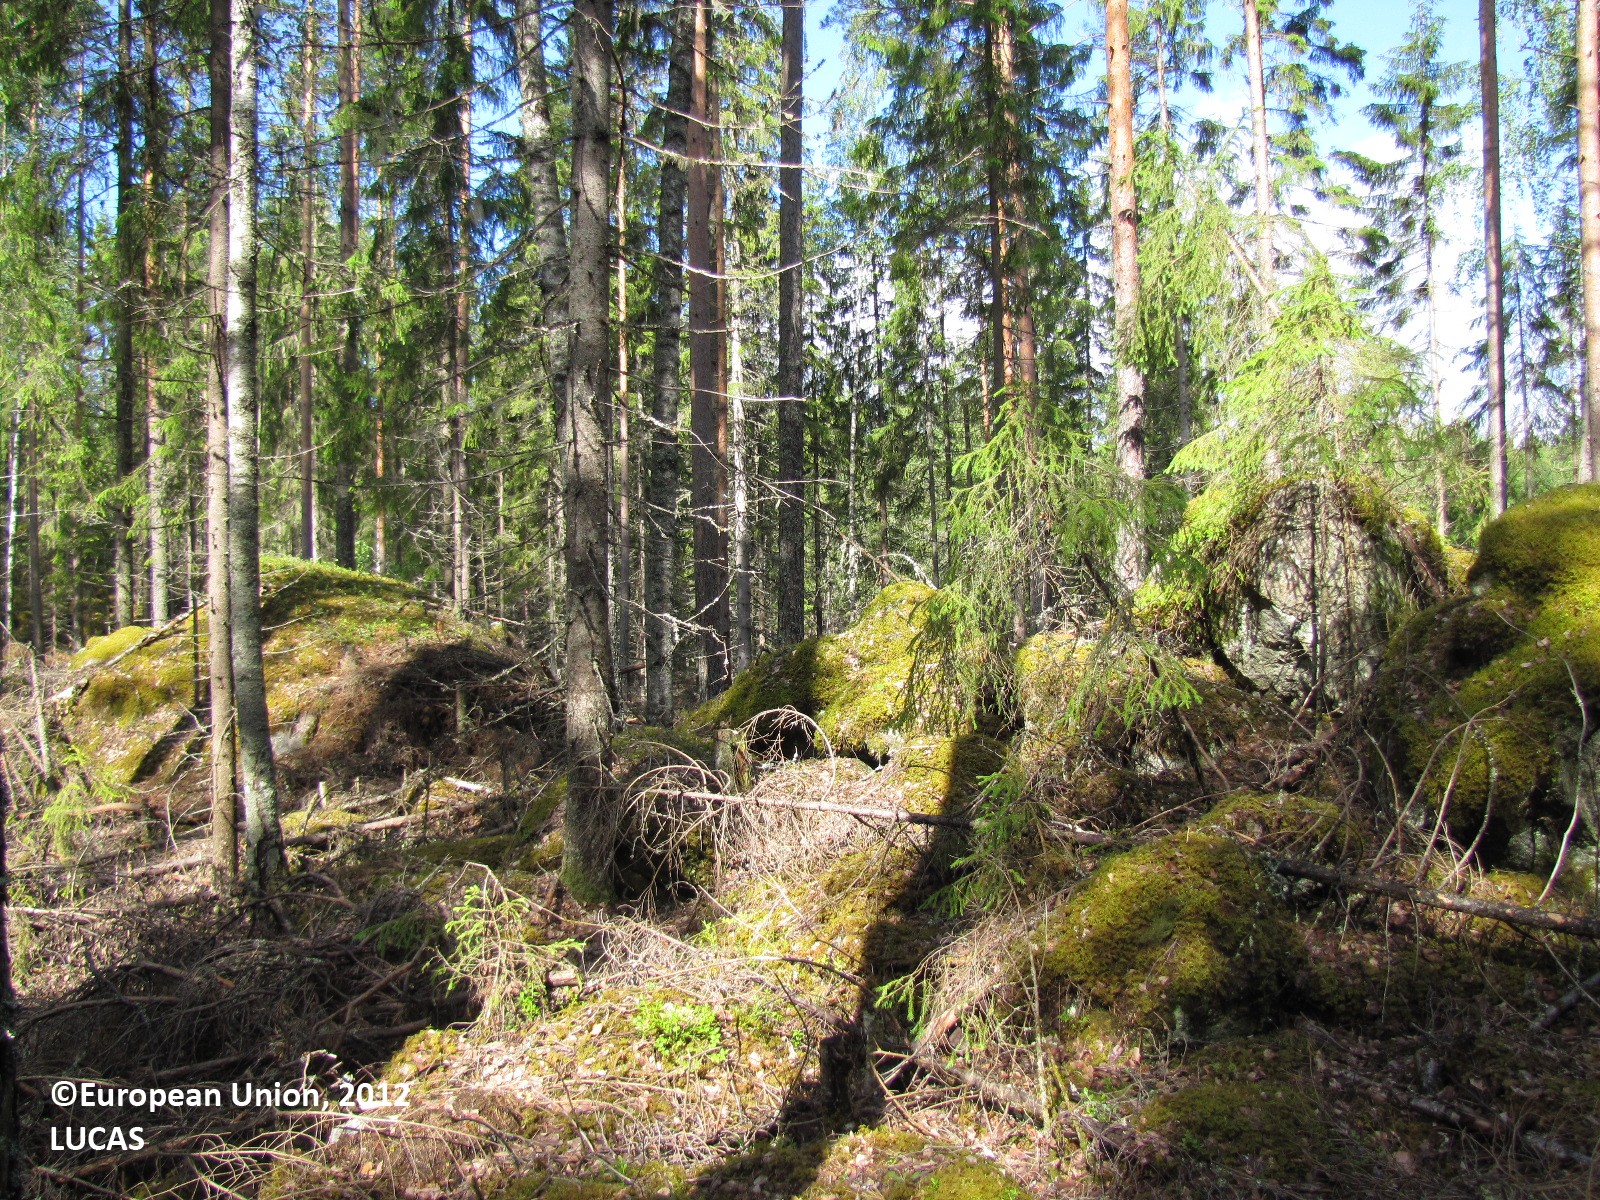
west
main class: Woodland
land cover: Pine dominated mixed woodland
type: boreal forest
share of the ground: 50 - 75 %
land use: Forestry
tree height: > 5 m
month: June
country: FI
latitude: 61.3936
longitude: 24.6502
